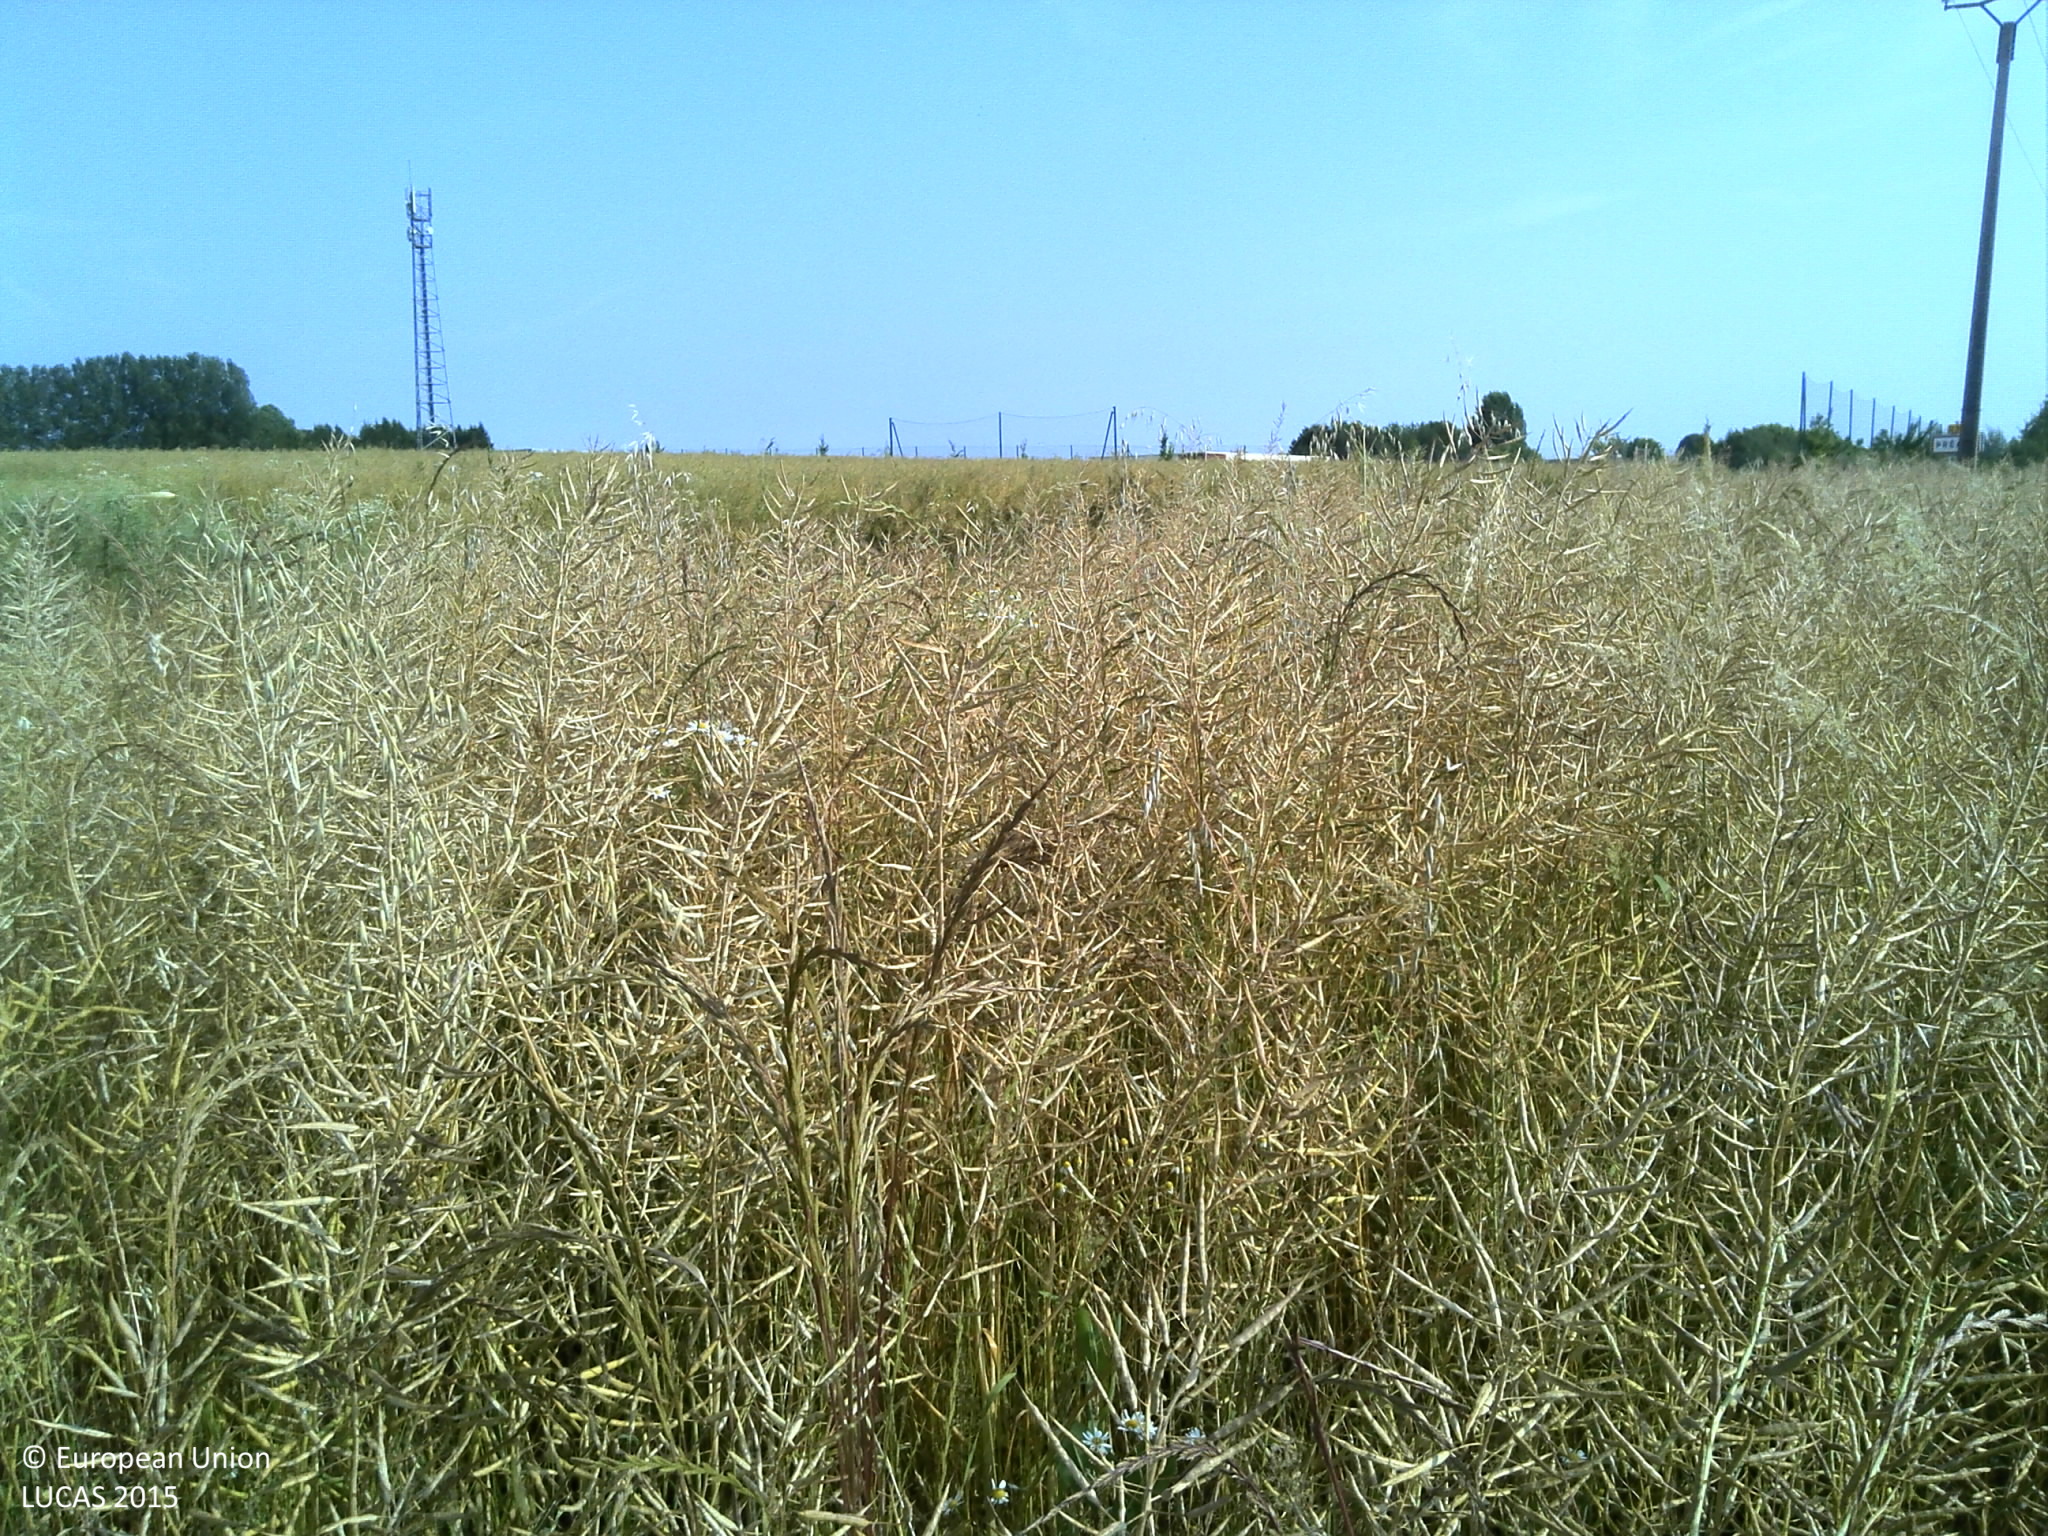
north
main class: Cropland
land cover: Rape and turnip rape
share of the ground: > 75 %
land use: Agriculture (excluding fallow land and kitchen gardens)
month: July
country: FR
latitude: 49.4828
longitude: 1.2144
